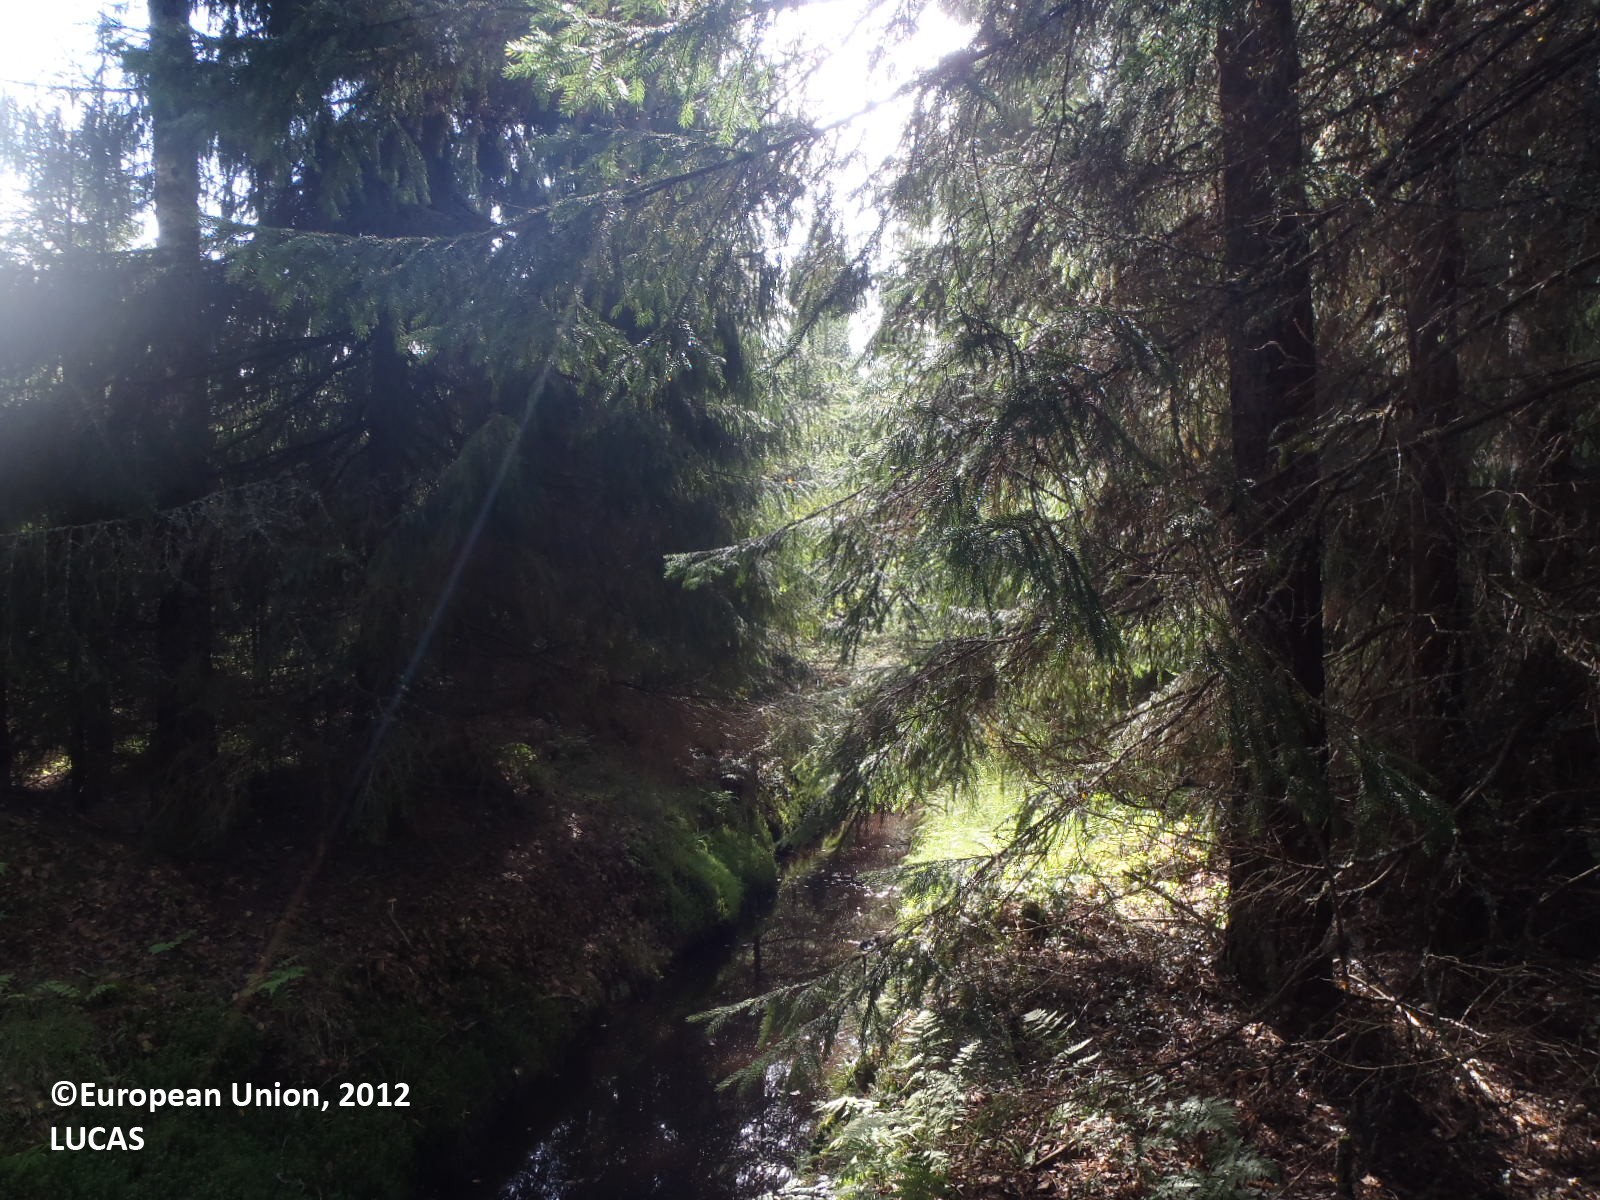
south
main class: Woodland
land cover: Other mixed woodland
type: boreal forest
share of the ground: > 75 %
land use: Forestry
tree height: > 5 m
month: August
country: FI
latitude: 60.7563
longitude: 22.2683
